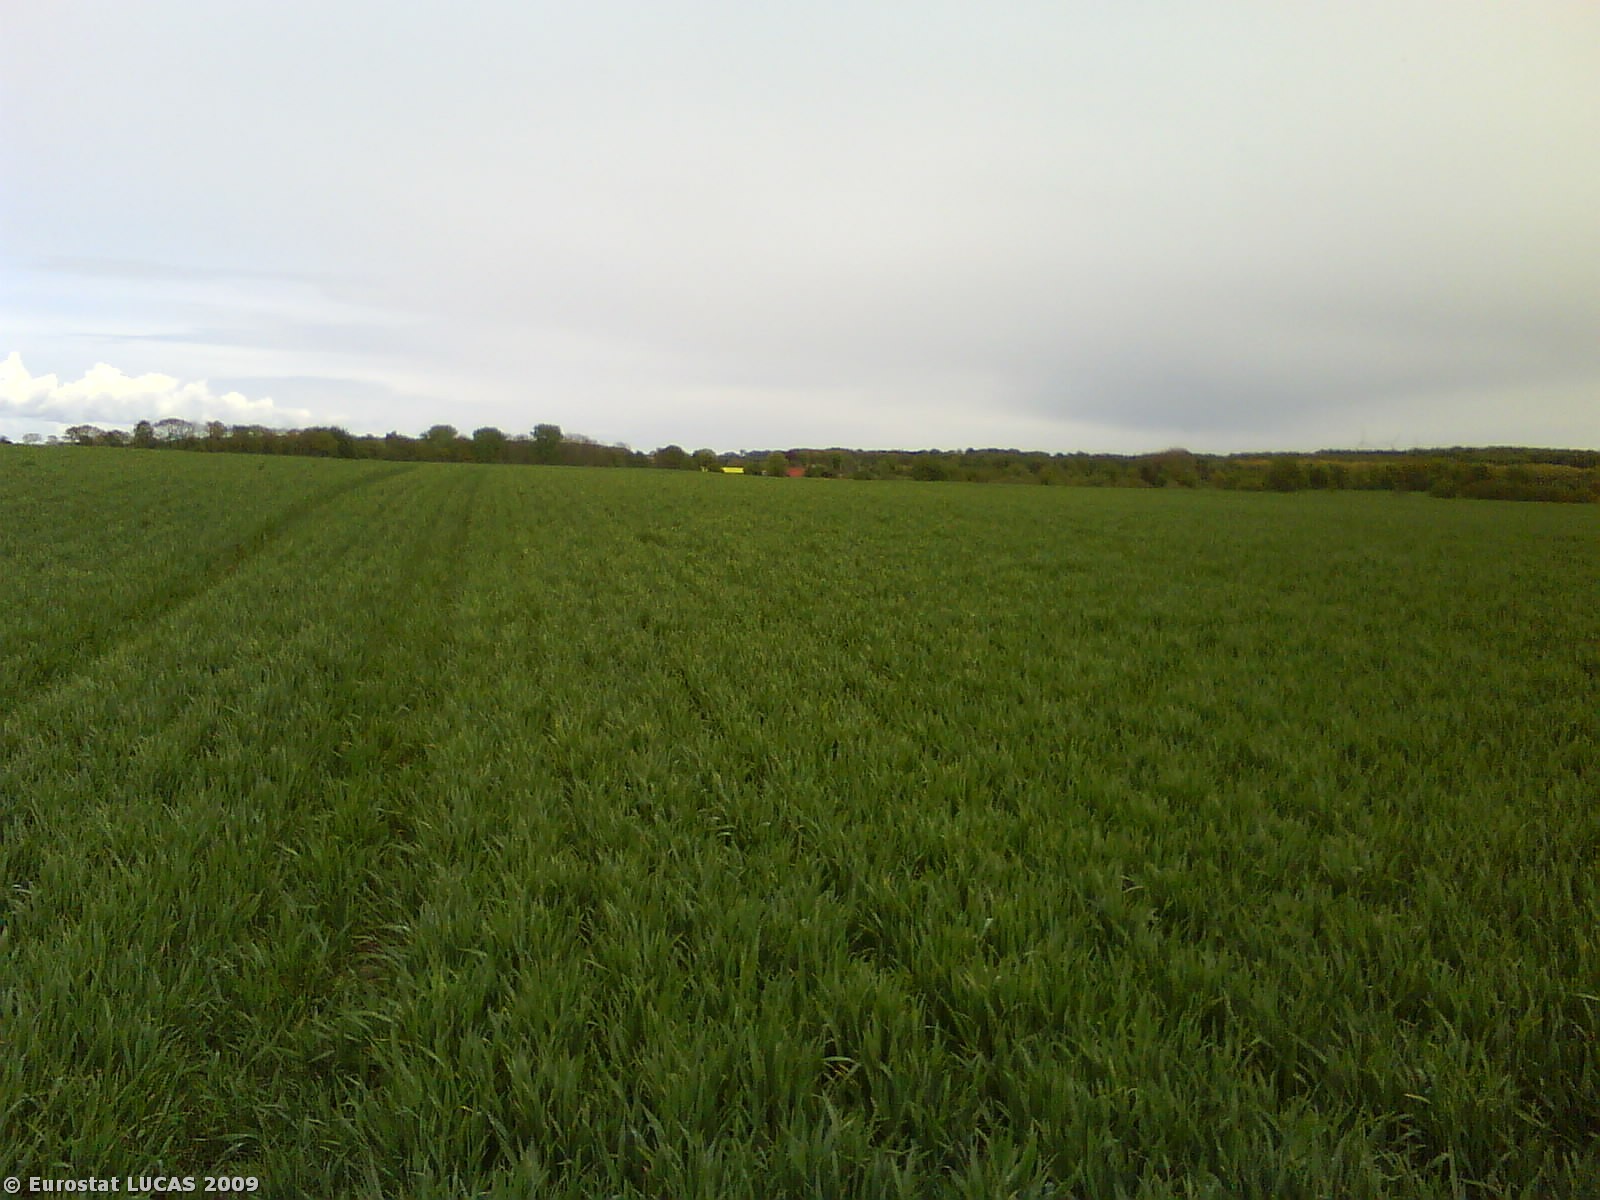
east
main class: Cropland
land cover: Common wheat
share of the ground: > 75 %
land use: Agriculture (excluding fallow land and kitchen gardens)
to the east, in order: Common wheat
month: May
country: DK
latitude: 56.3314
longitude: 10.2100
